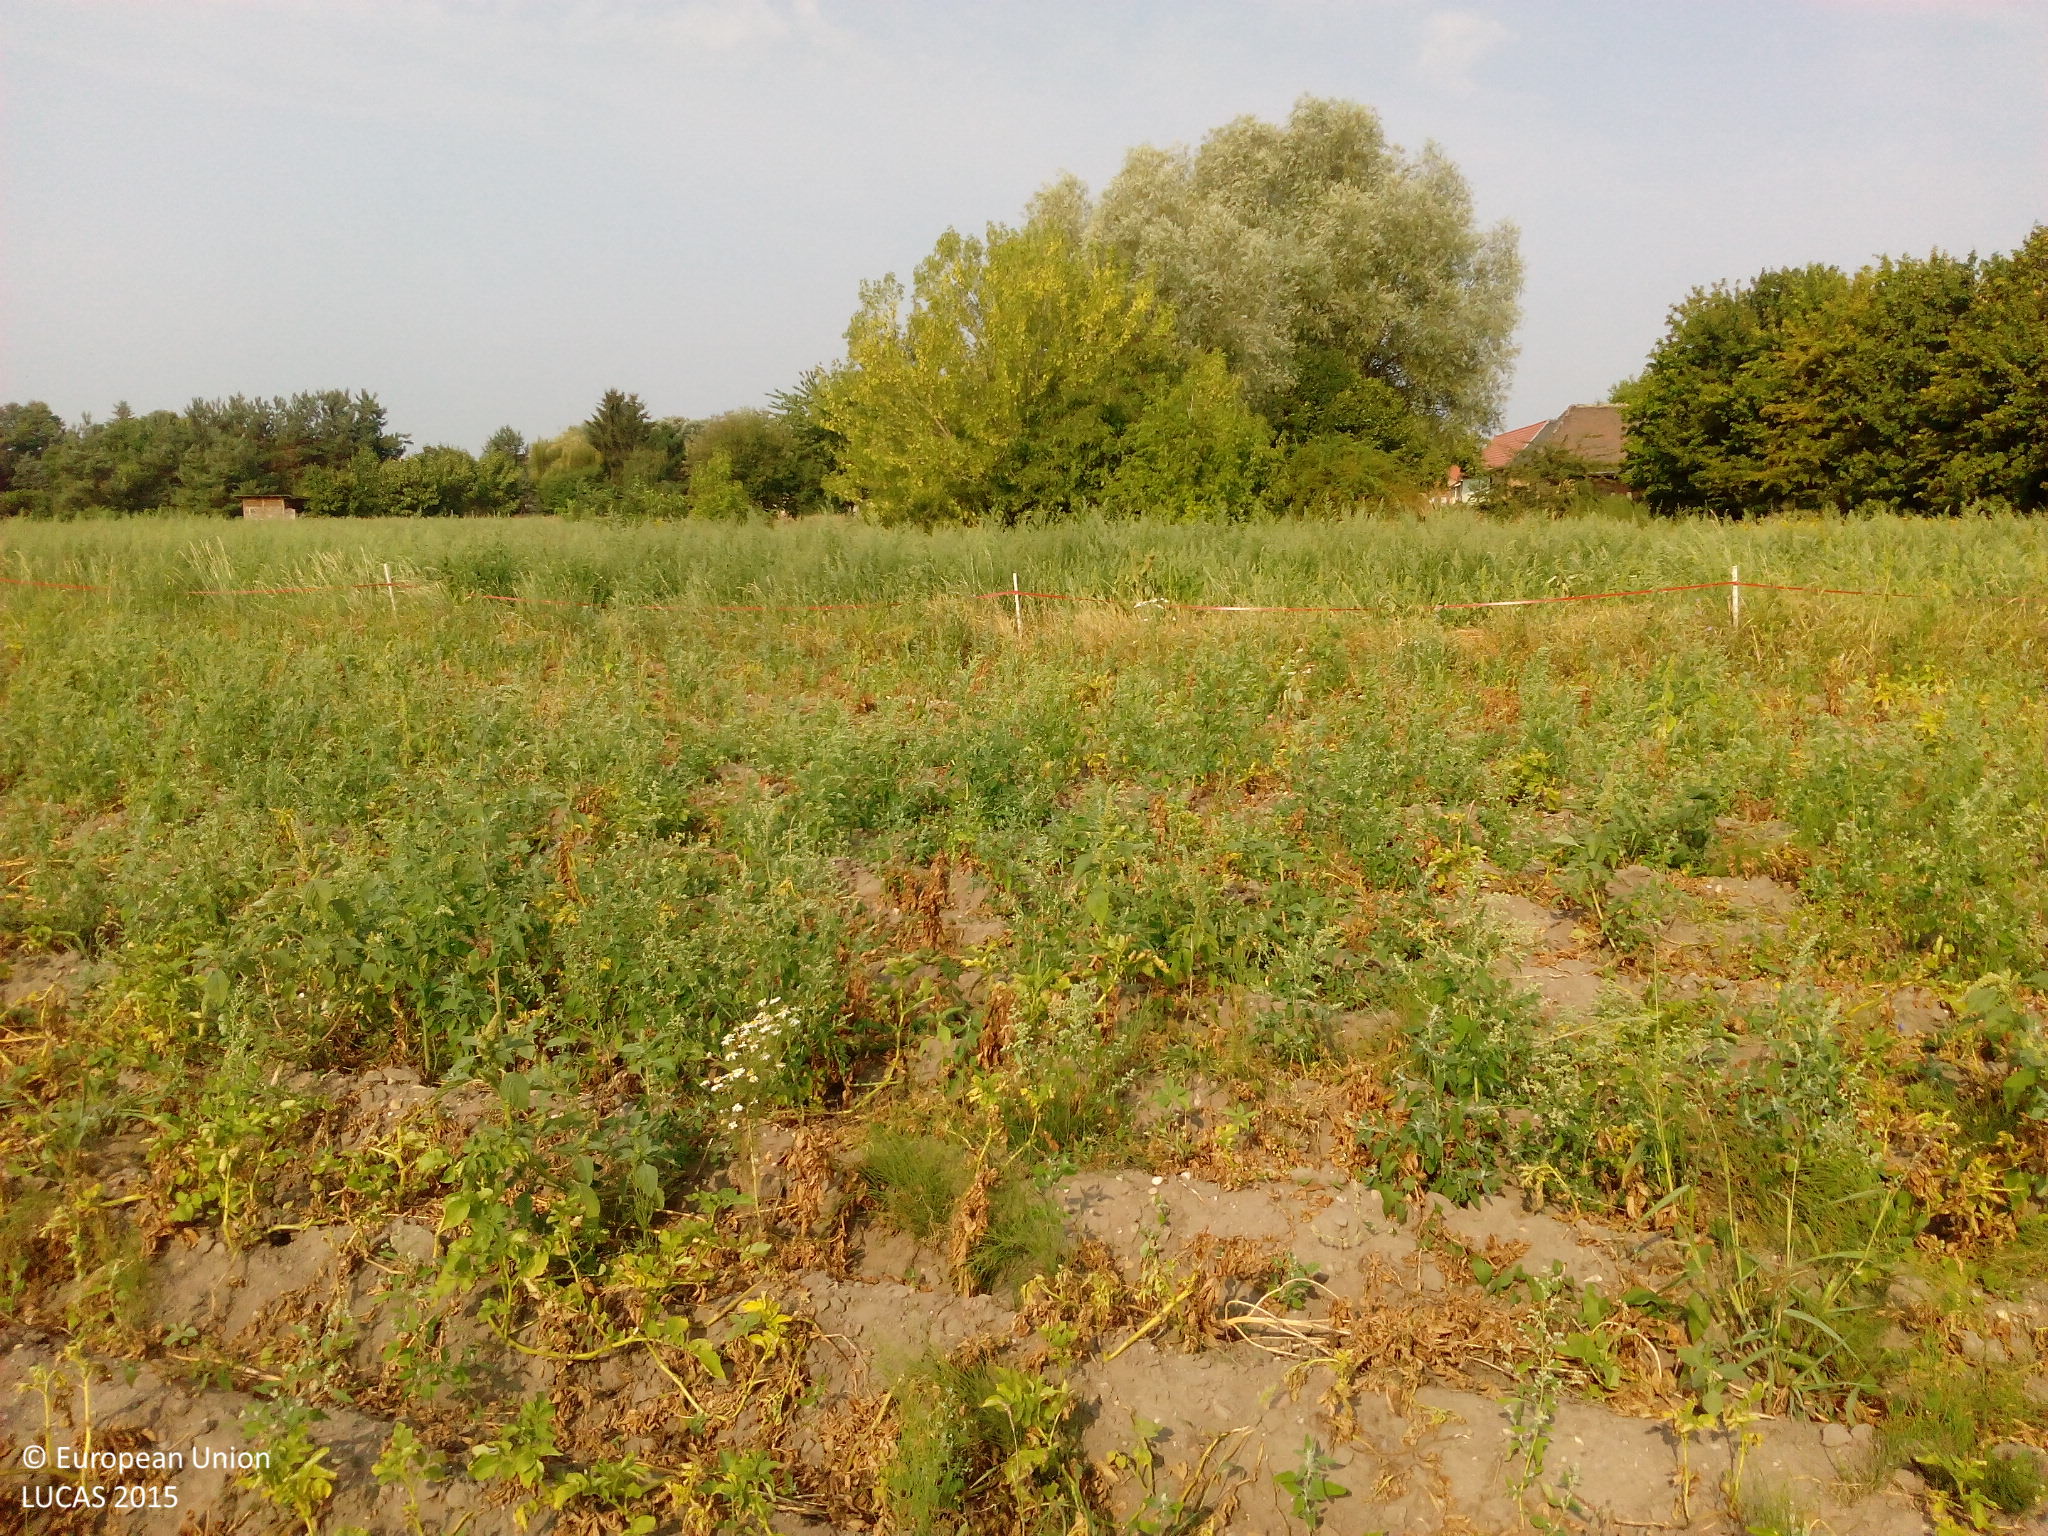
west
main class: Cropland
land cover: Potatoes
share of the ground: > 75 %
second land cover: Spontaneously vegetated surfaces
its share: 50 - 75 %
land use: Agriculture (excluding fallow land and kitchen gardens)
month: August
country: DE
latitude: 51.7223
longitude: 12.4751
